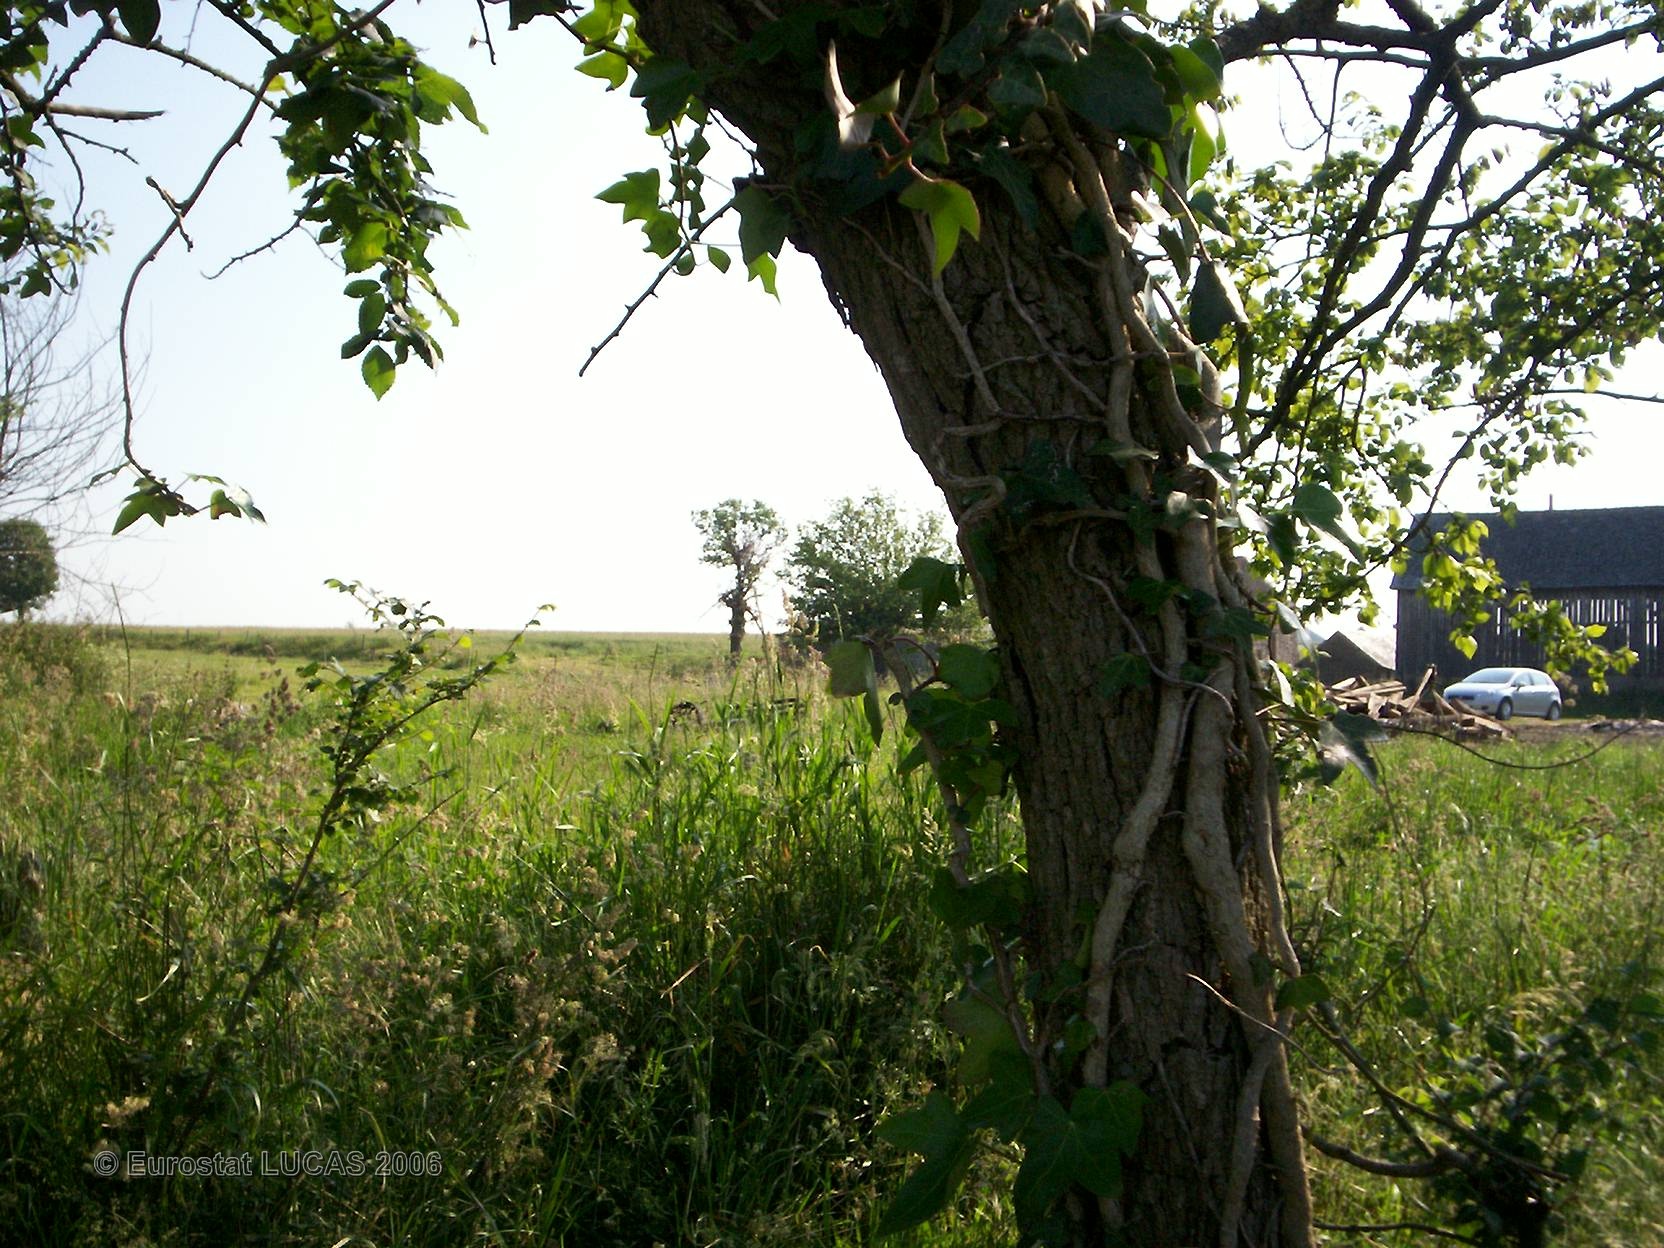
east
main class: Grassland
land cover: Grassland without tree/shrub cover
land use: Wetland
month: April
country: FR
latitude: 48.0378
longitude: -1.3228
